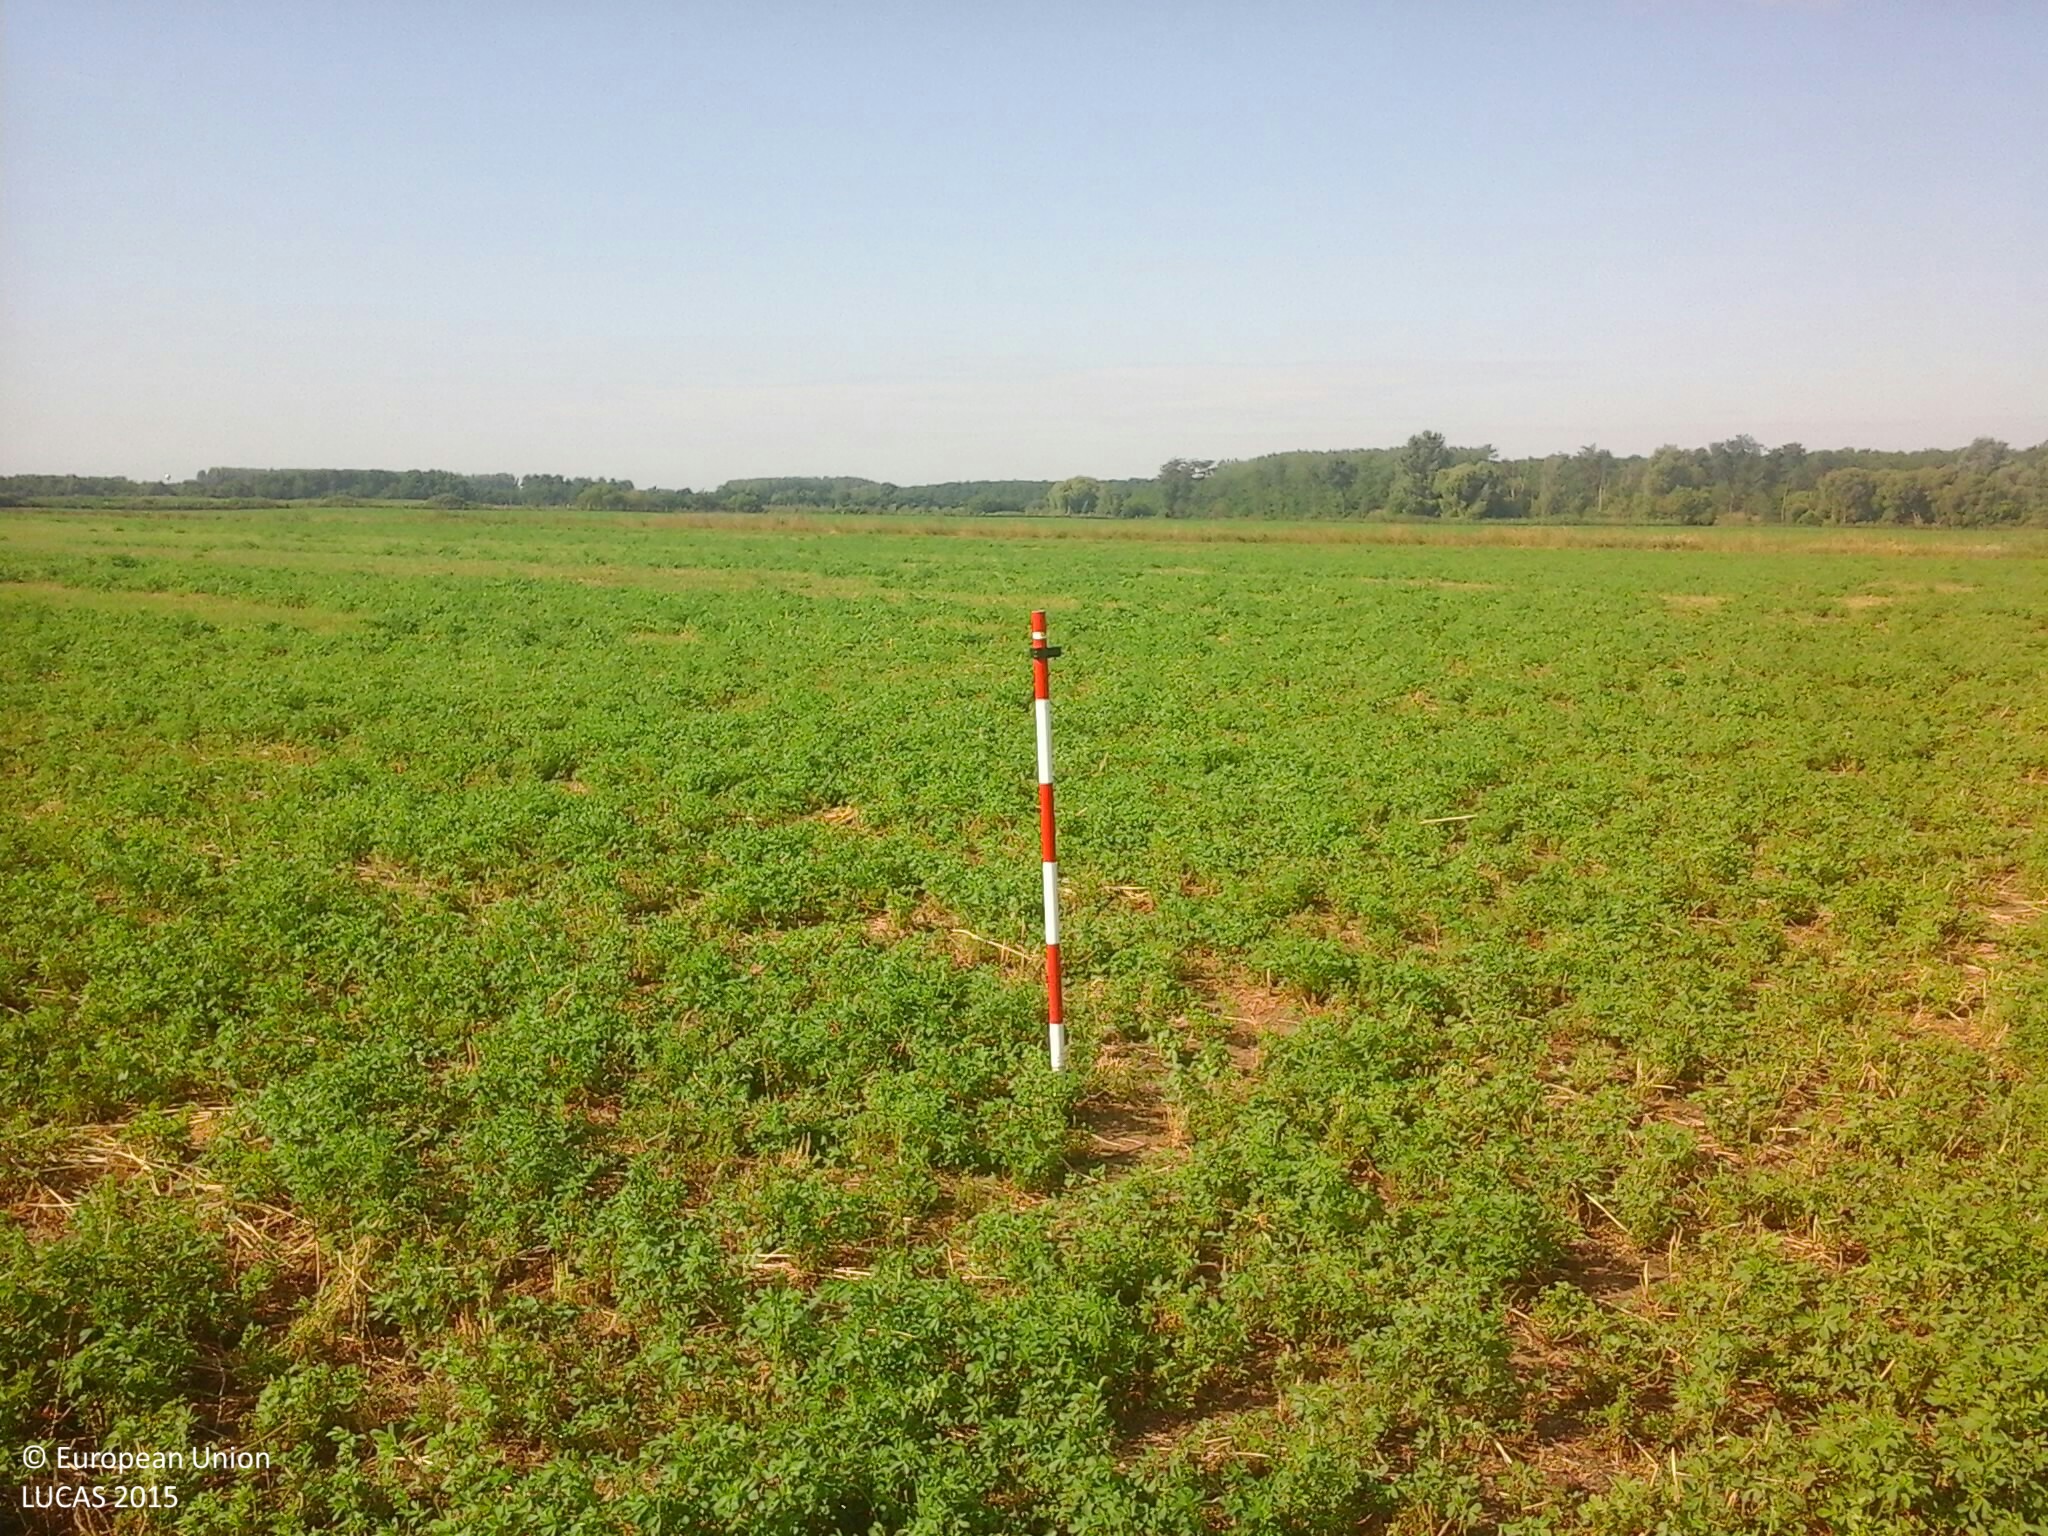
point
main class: Cropland
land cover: Lucerne
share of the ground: > 75 %
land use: Agriculture (excluding fallow land and kitchen gardens)
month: July
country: HU
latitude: 47.8018
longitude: 22.1635
